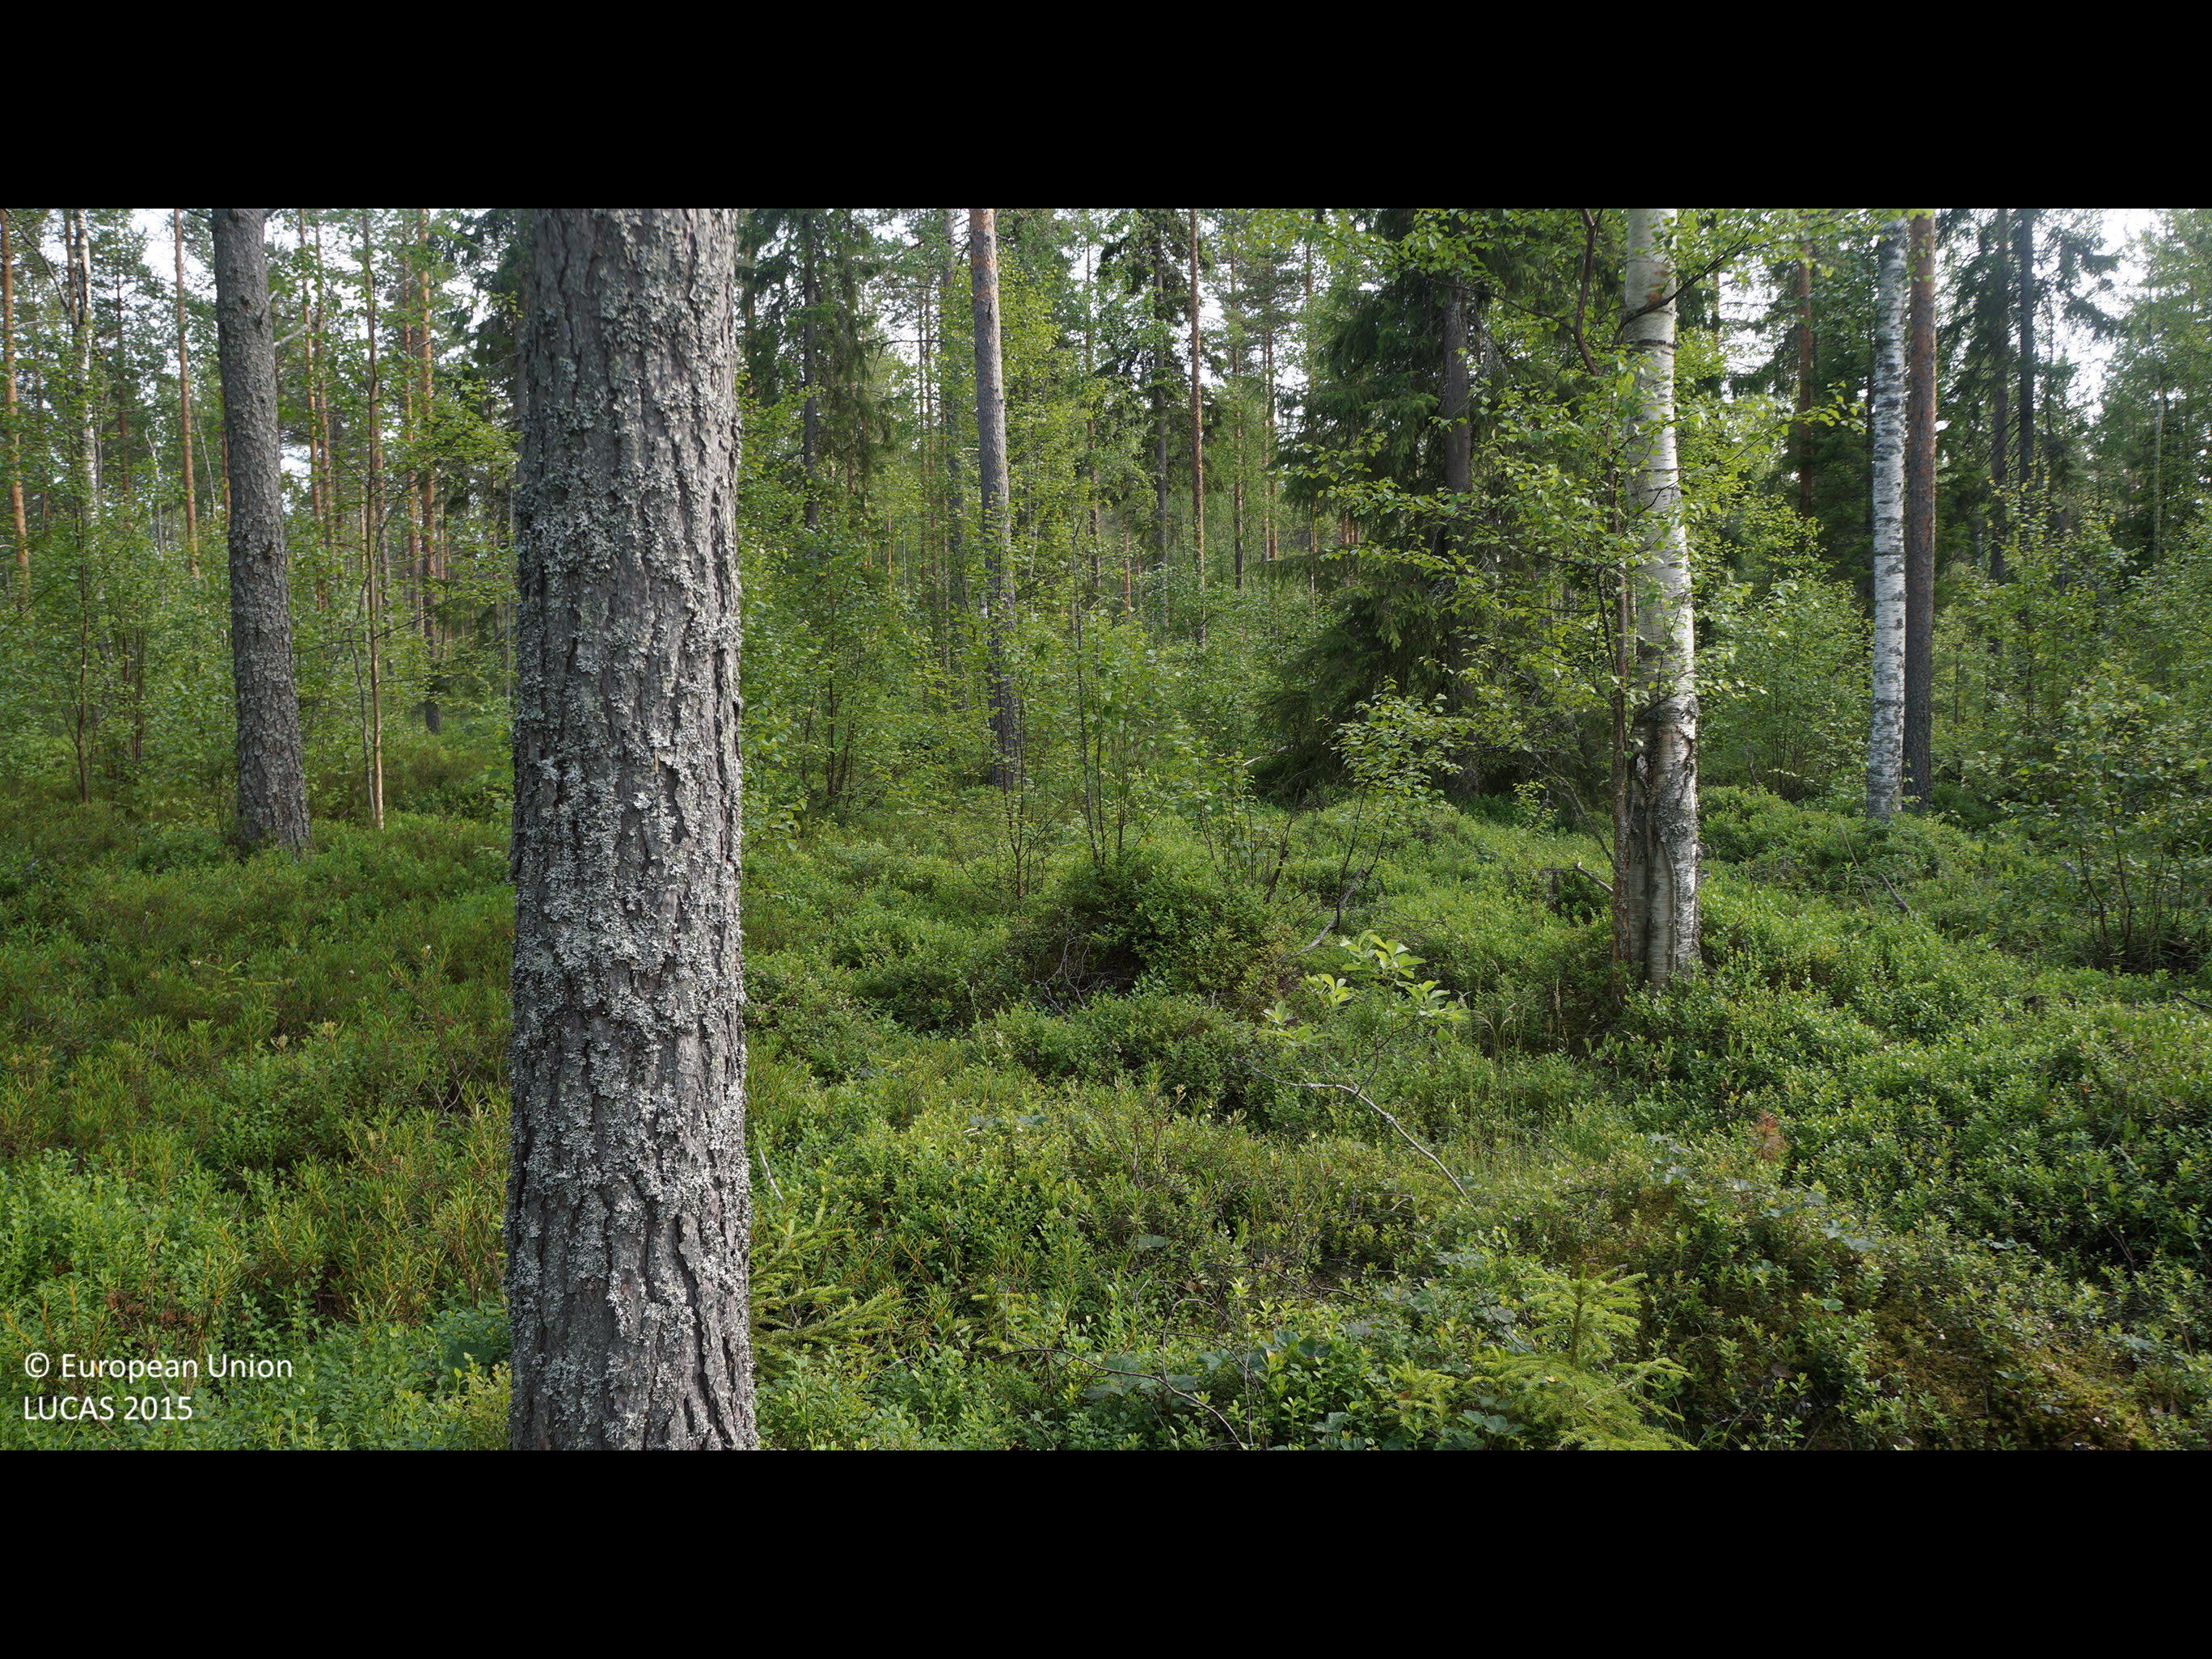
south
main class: Woodland
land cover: Other mixed woodland
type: boreal forest
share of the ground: 50 - 75 %
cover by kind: shrubs 40 %, coniferous forest trees 35 %, broadleaved forest trees 15 %, herbaceous plants 5 %, lichens and mosses 5 %
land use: Forestry
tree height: > 5 m
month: July
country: FI
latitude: 64.6702
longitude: 24.6718
